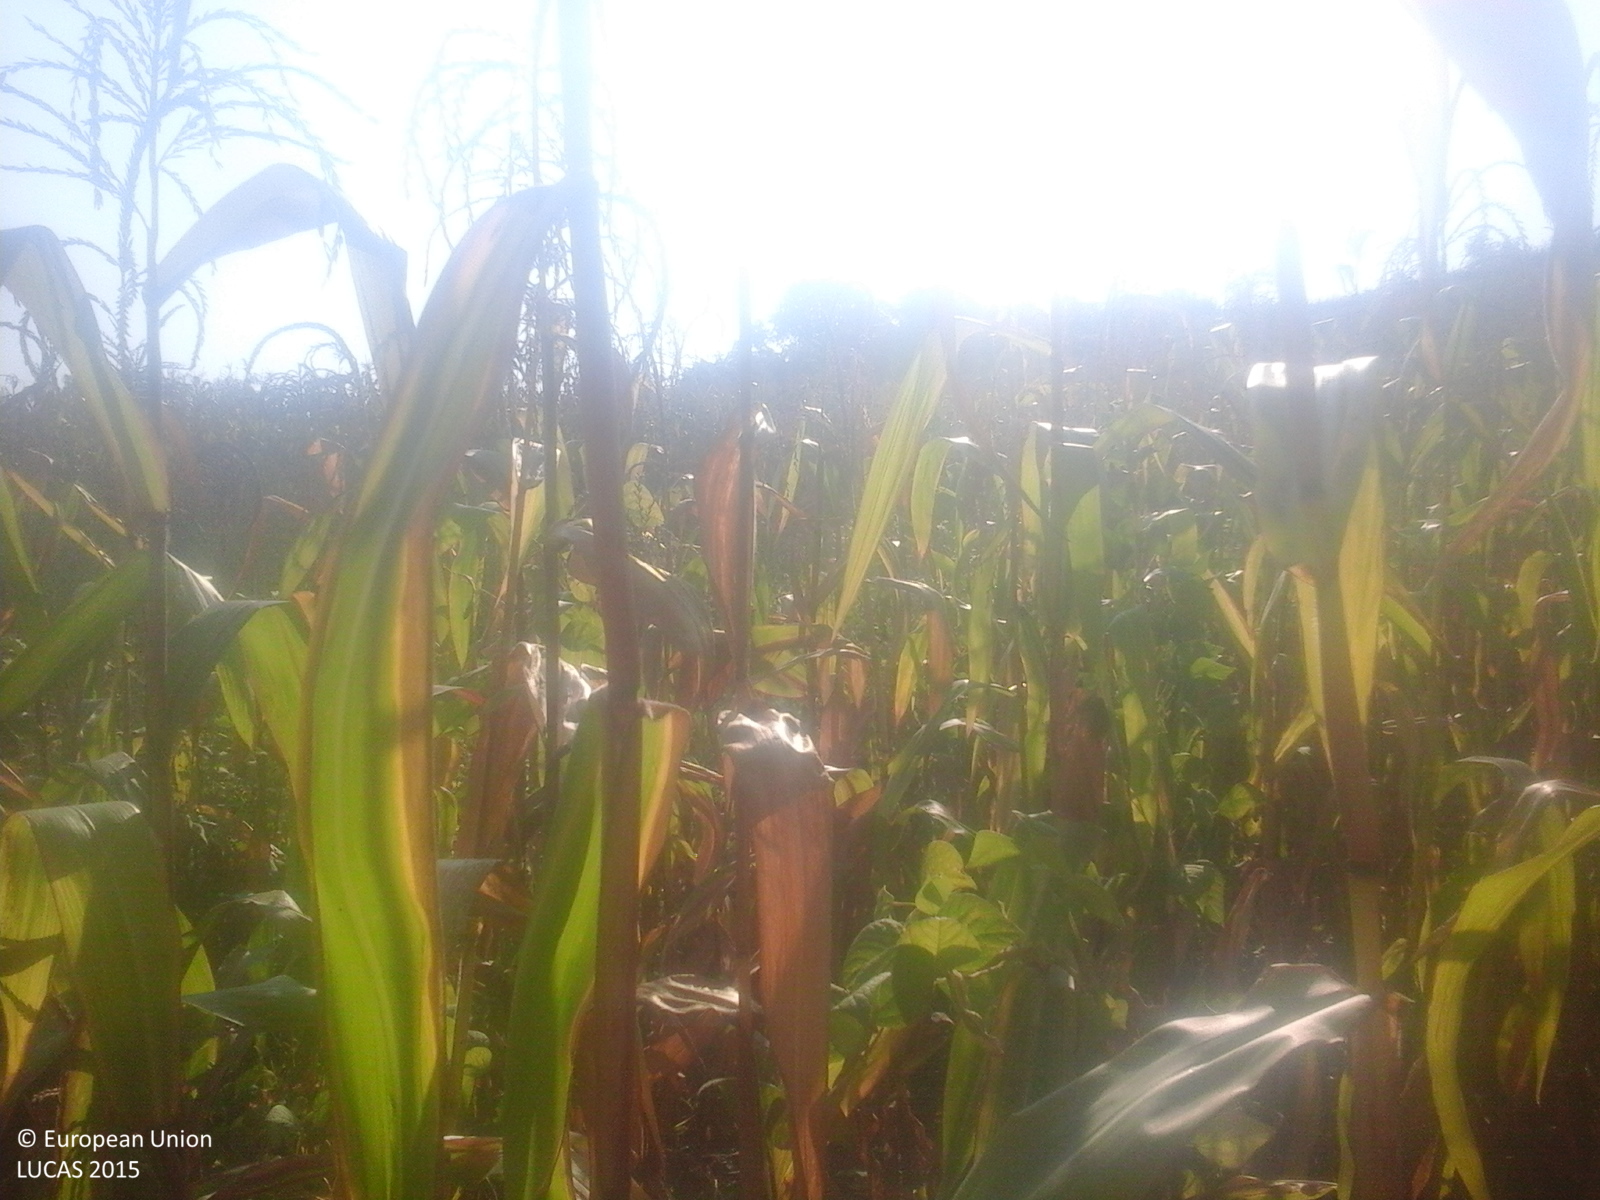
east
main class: Cropland
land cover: Maize
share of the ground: > 75 %
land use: Agriculture (excluding fallow land and kitchen gardens)
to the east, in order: Maize; Spontaneously vegetated surfaces; Maize; Tracks; Spontaneously vegetated surfaces; Tracks; Grassland without tree/shrub cover; Tracks; Grassland without tree/shrub cover; Shruby margins; Maize; Grassland without tree/shrub cover; Abandoned hedges; Tracks; Lines of trees; Maize
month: September
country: RO
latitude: 46.8592
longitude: 24.4779
